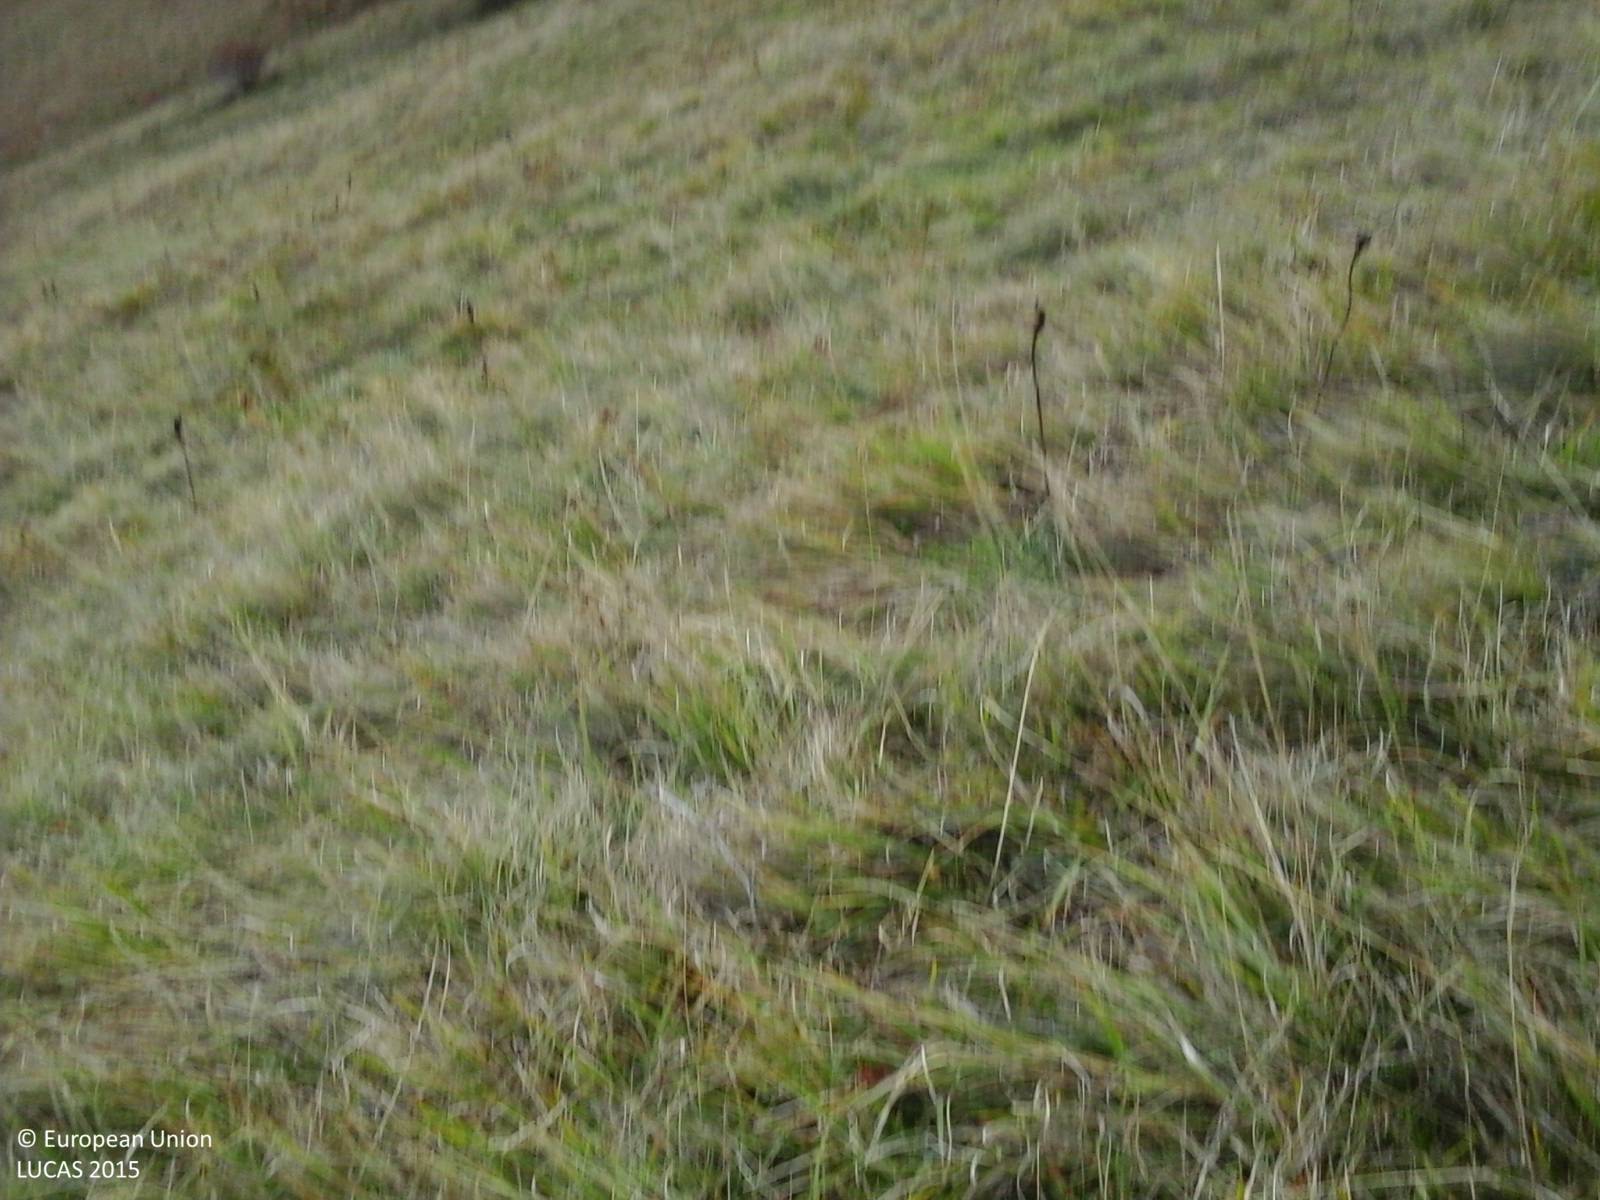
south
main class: Grassland
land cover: Grassland without tree/shrub cover
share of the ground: > 75 %
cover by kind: herbaceous plants 100 %
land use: Agriculture (excluding fallow land and kitchen gardens)
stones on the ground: < 10 %
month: October
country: IT
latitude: 42.7848
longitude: 13.1811
